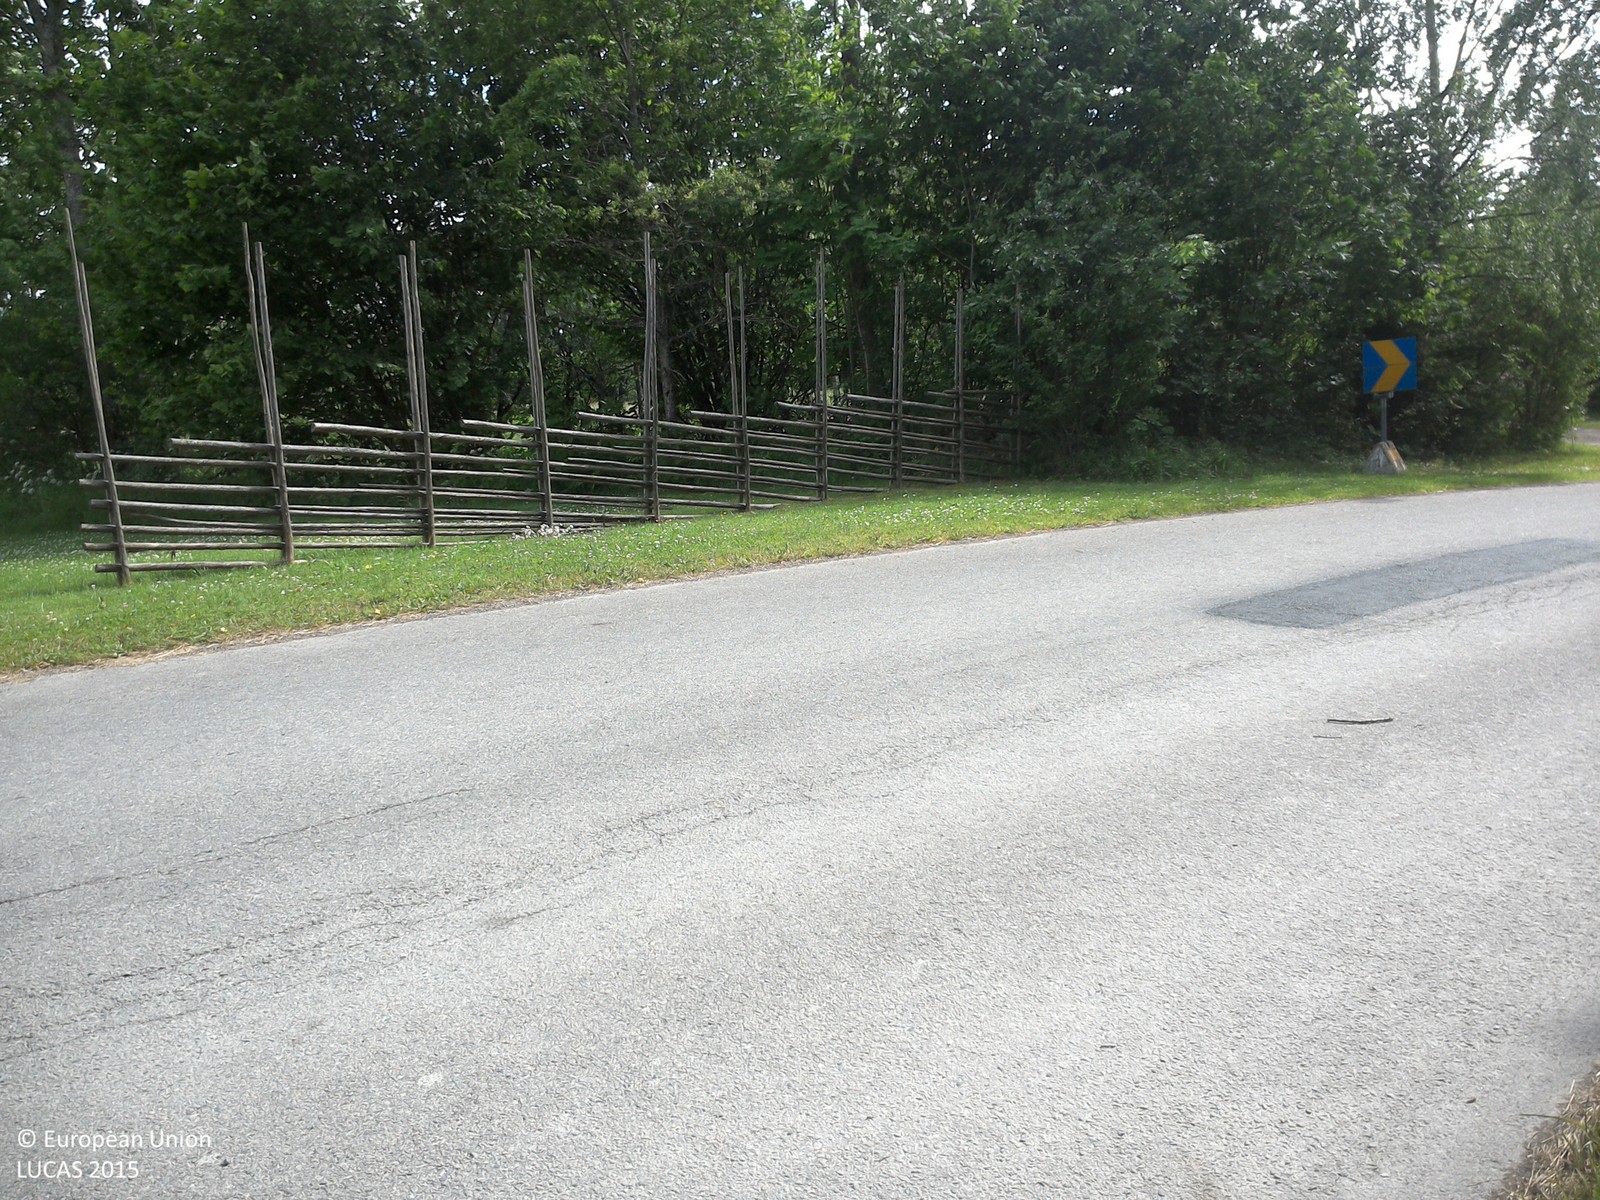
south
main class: Woodland
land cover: Broadleaved woodland
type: boreal forest
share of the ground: > 75 %
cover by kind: broadleaved forest trees 85 %, herbaceous plants 15 %
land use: Forestry
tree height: > 5 m
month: July
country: SE
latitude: 58.5376
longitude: 15.0954
